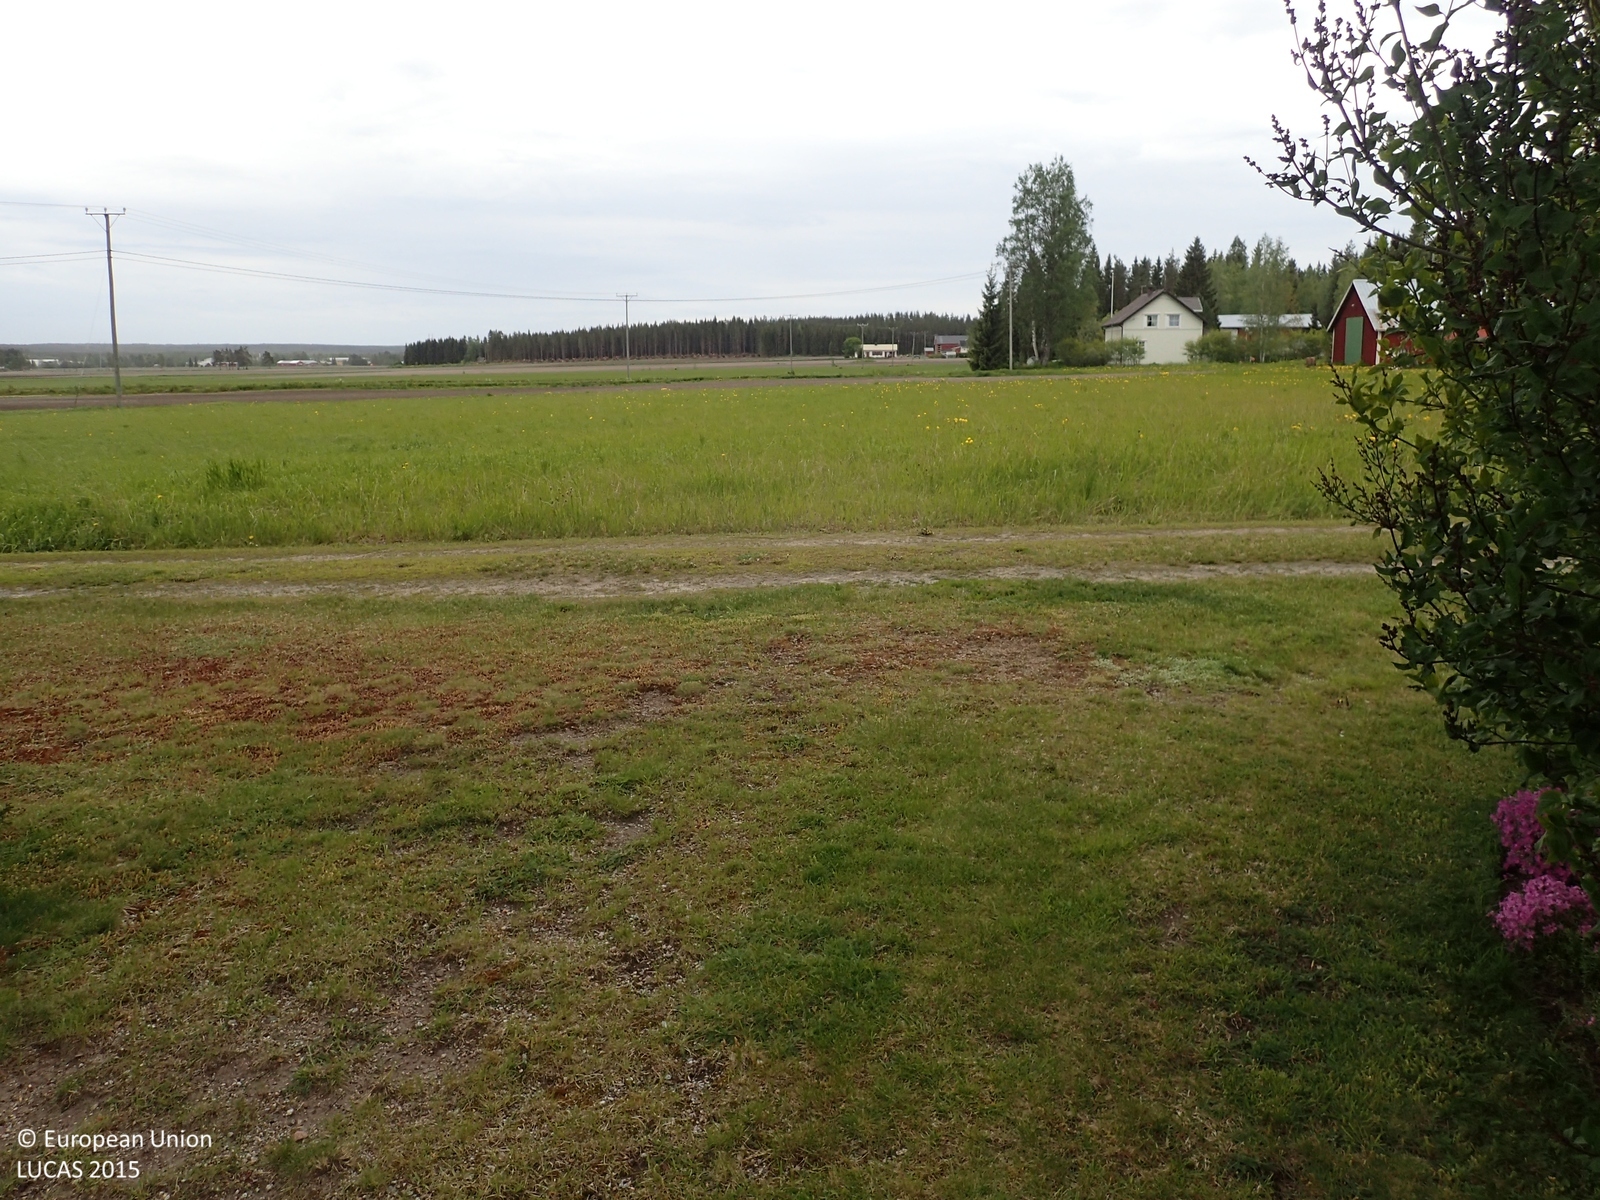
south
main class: Woodland
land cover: Spruce dominated mixed woodland
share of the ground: 10 - 25 %
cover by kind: herbaceous plants 65 %, coniferous forest trees 5 %, broadleaved forest trees 5 %
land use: Residential
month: June
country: FI
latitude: 62.2672
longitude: 21.6623
